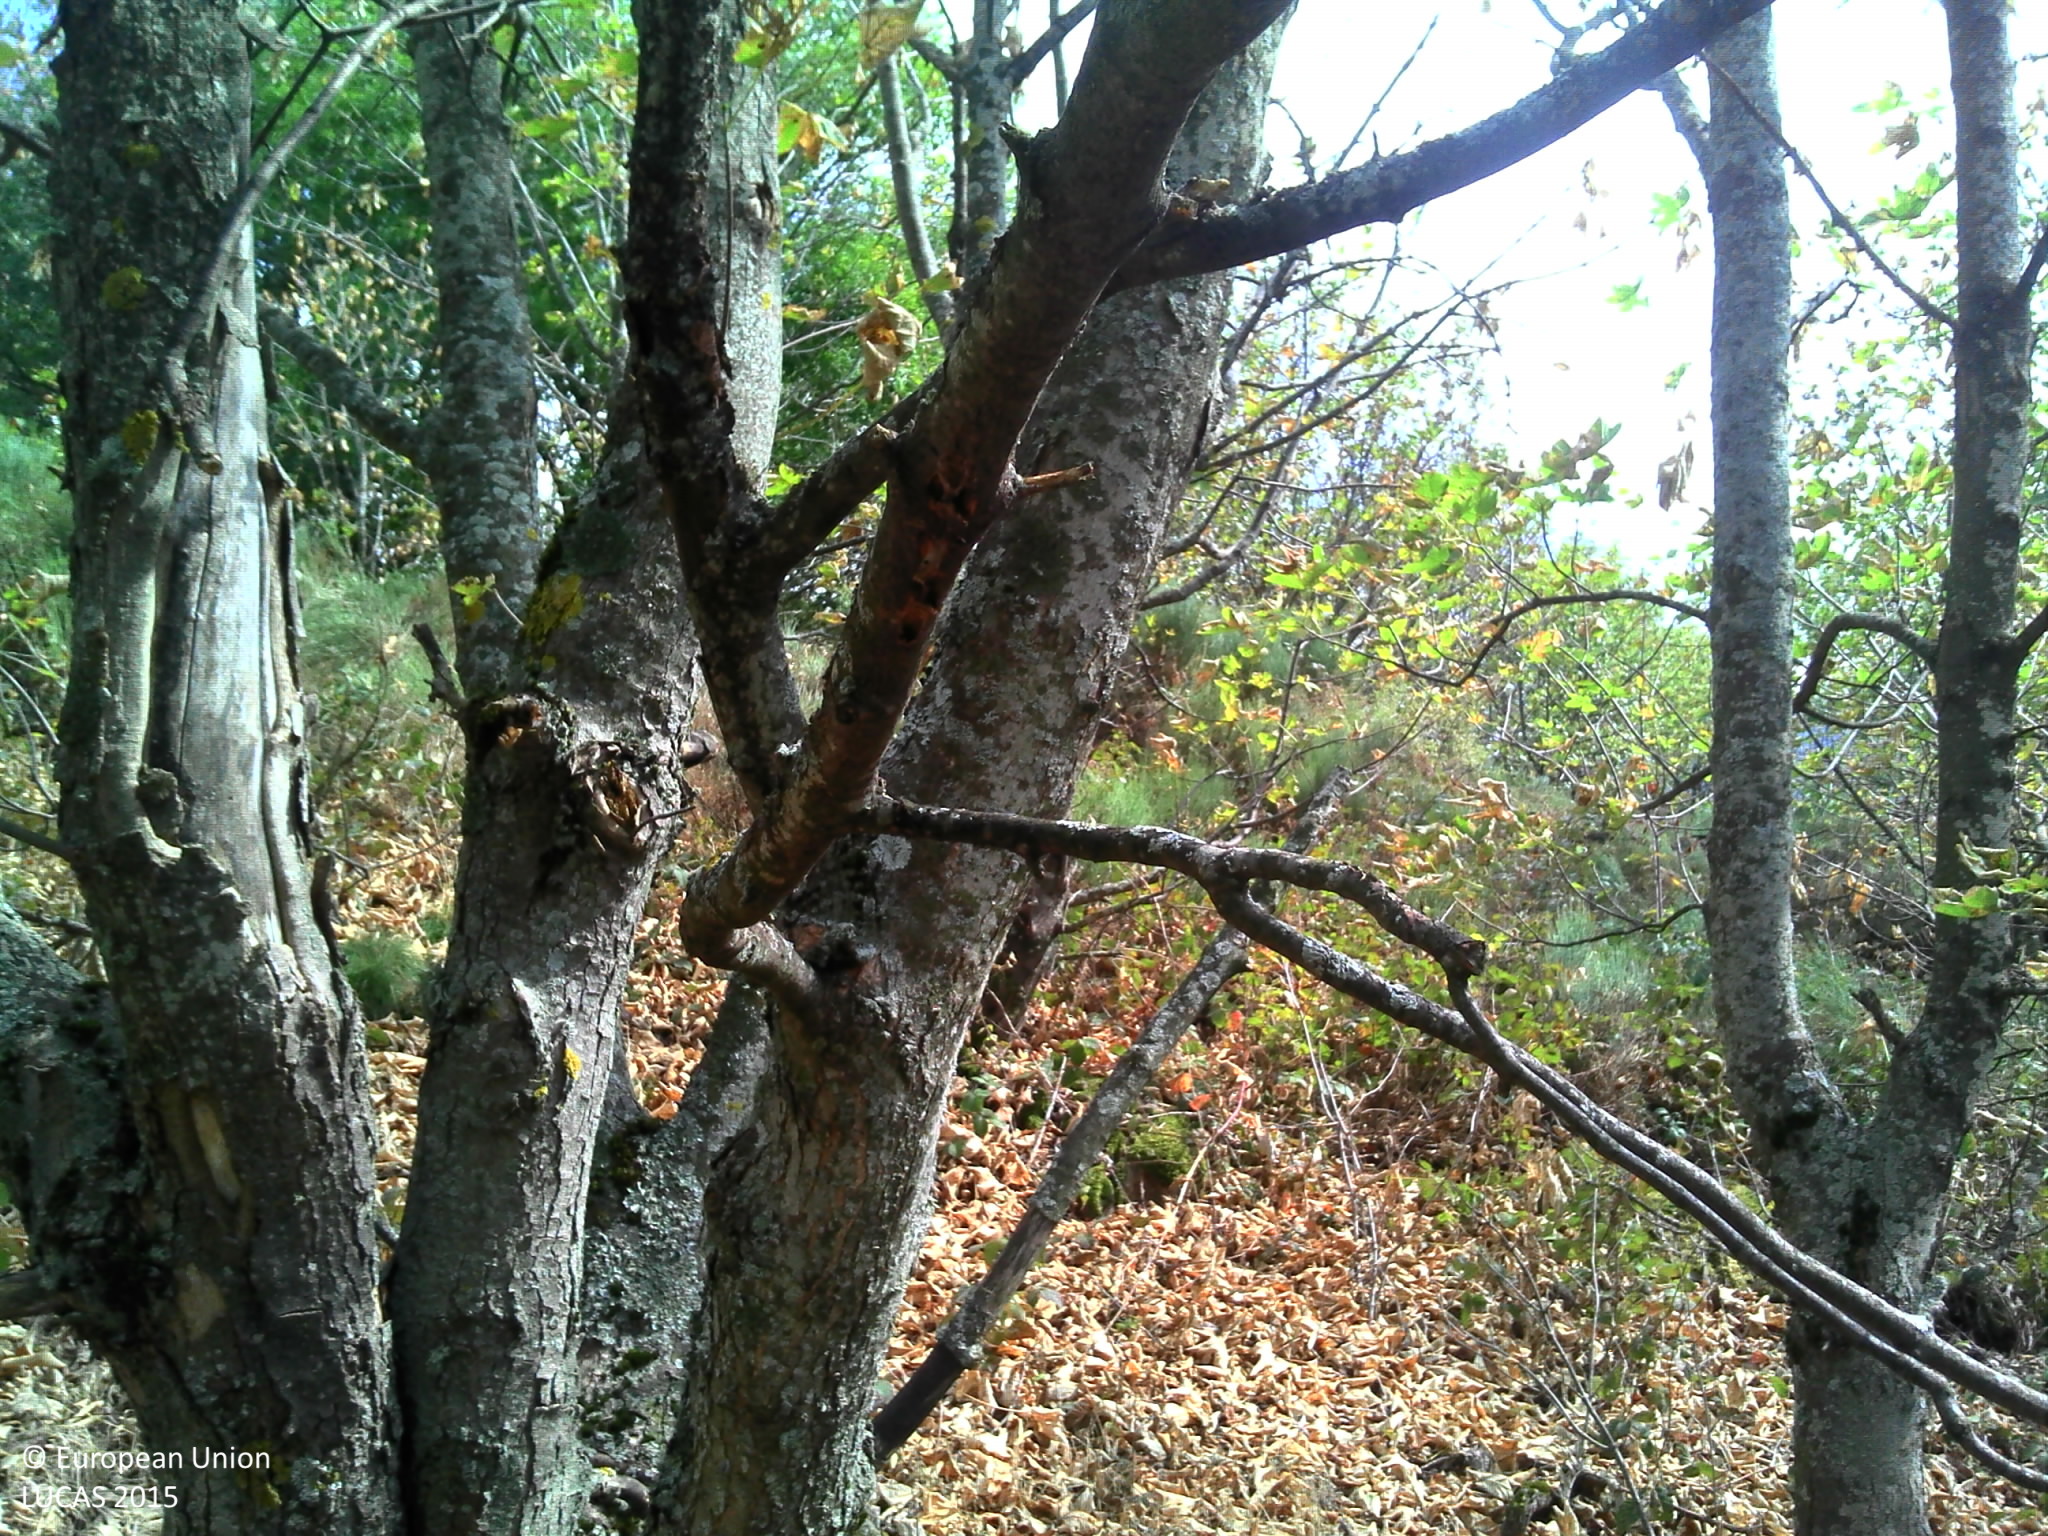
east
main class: Woodland
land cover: Broadleaved woodland
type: mesophytic deciduous forest
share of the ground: > 75 %
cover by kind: broadleaved forest trees 90 %, herbaceous plants 10 %
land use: Agriculture (excluding fallow land and kitchen gardens)
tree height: > 5 m
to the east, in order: Broadleaved woodland; Tracks; Broadleaved woodland; Durum wheat; Fences; Grassland without tree/shrub cover; Electric lines; Grassland without tree/shrub cover
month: September
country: FR
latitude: 45.2906
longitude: 4.5345
